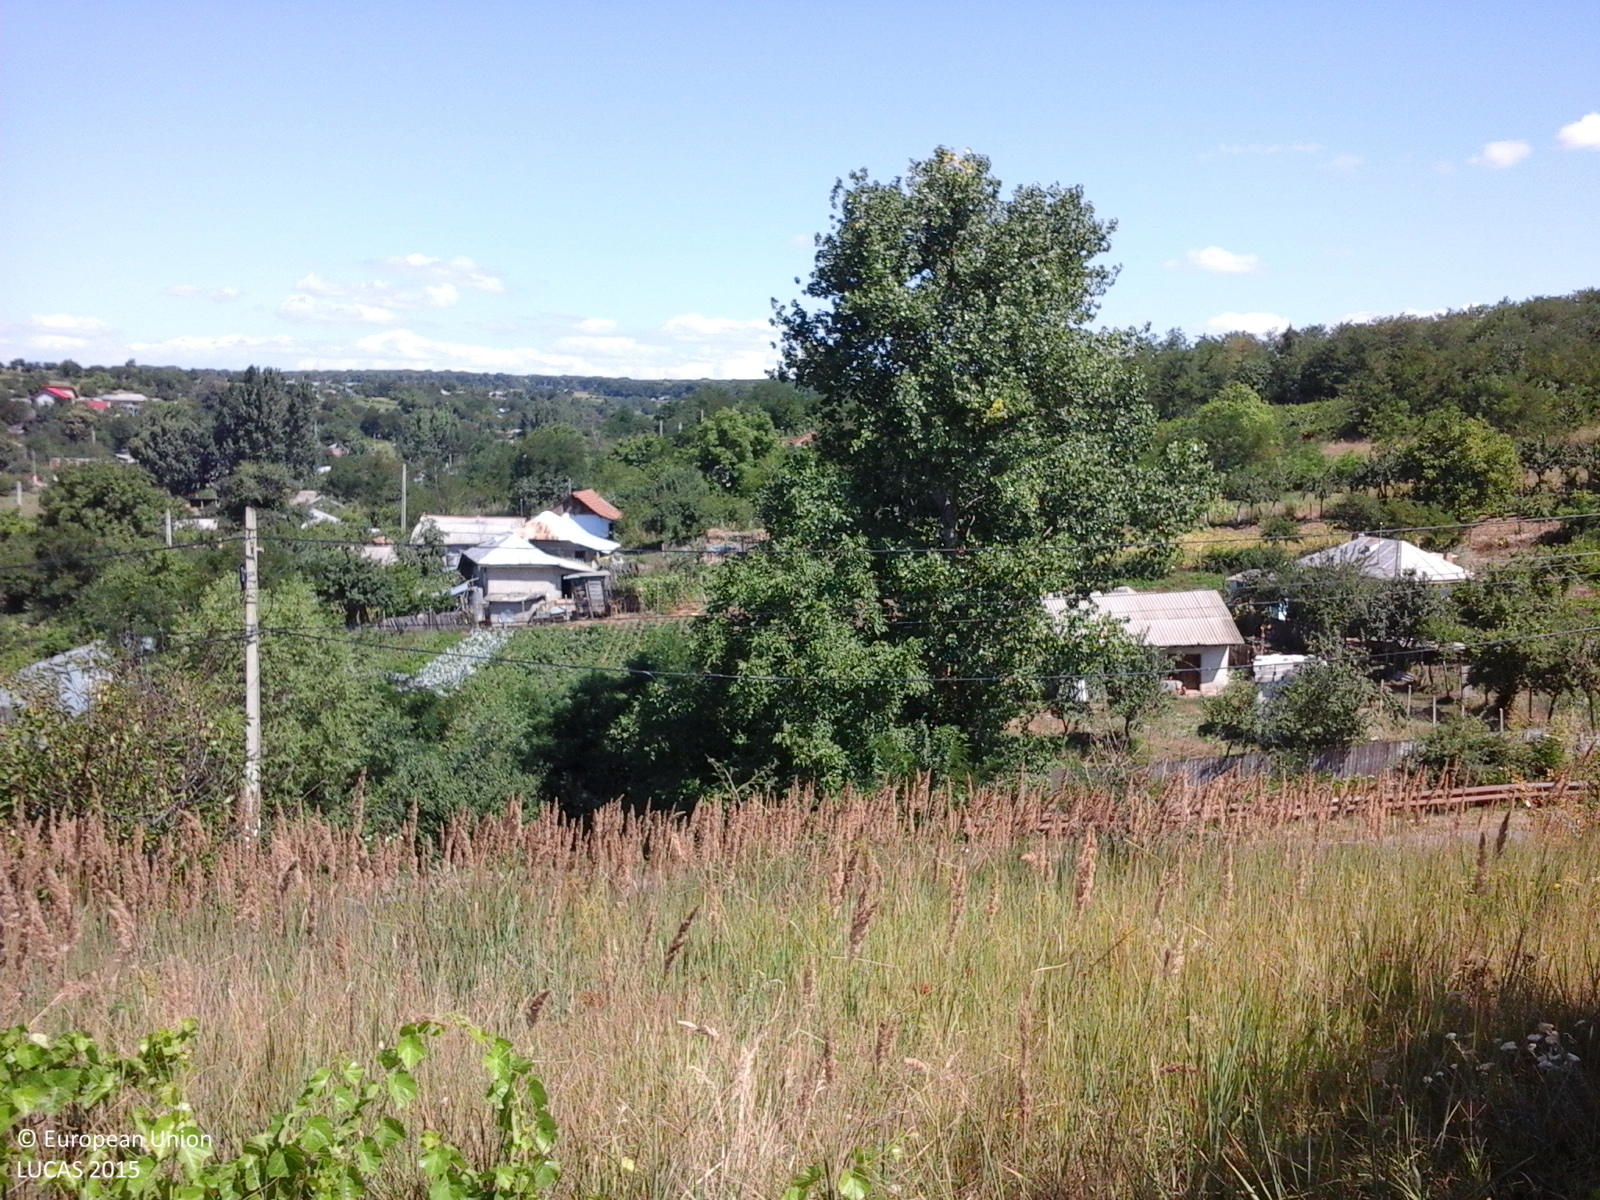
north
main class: Cropland
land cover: Vineyards
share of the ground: > 75 %
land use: Agriculture (excluding fallow land and kitchen gardens)
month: July
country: RO
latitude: 45.9782
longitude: 27.7321
